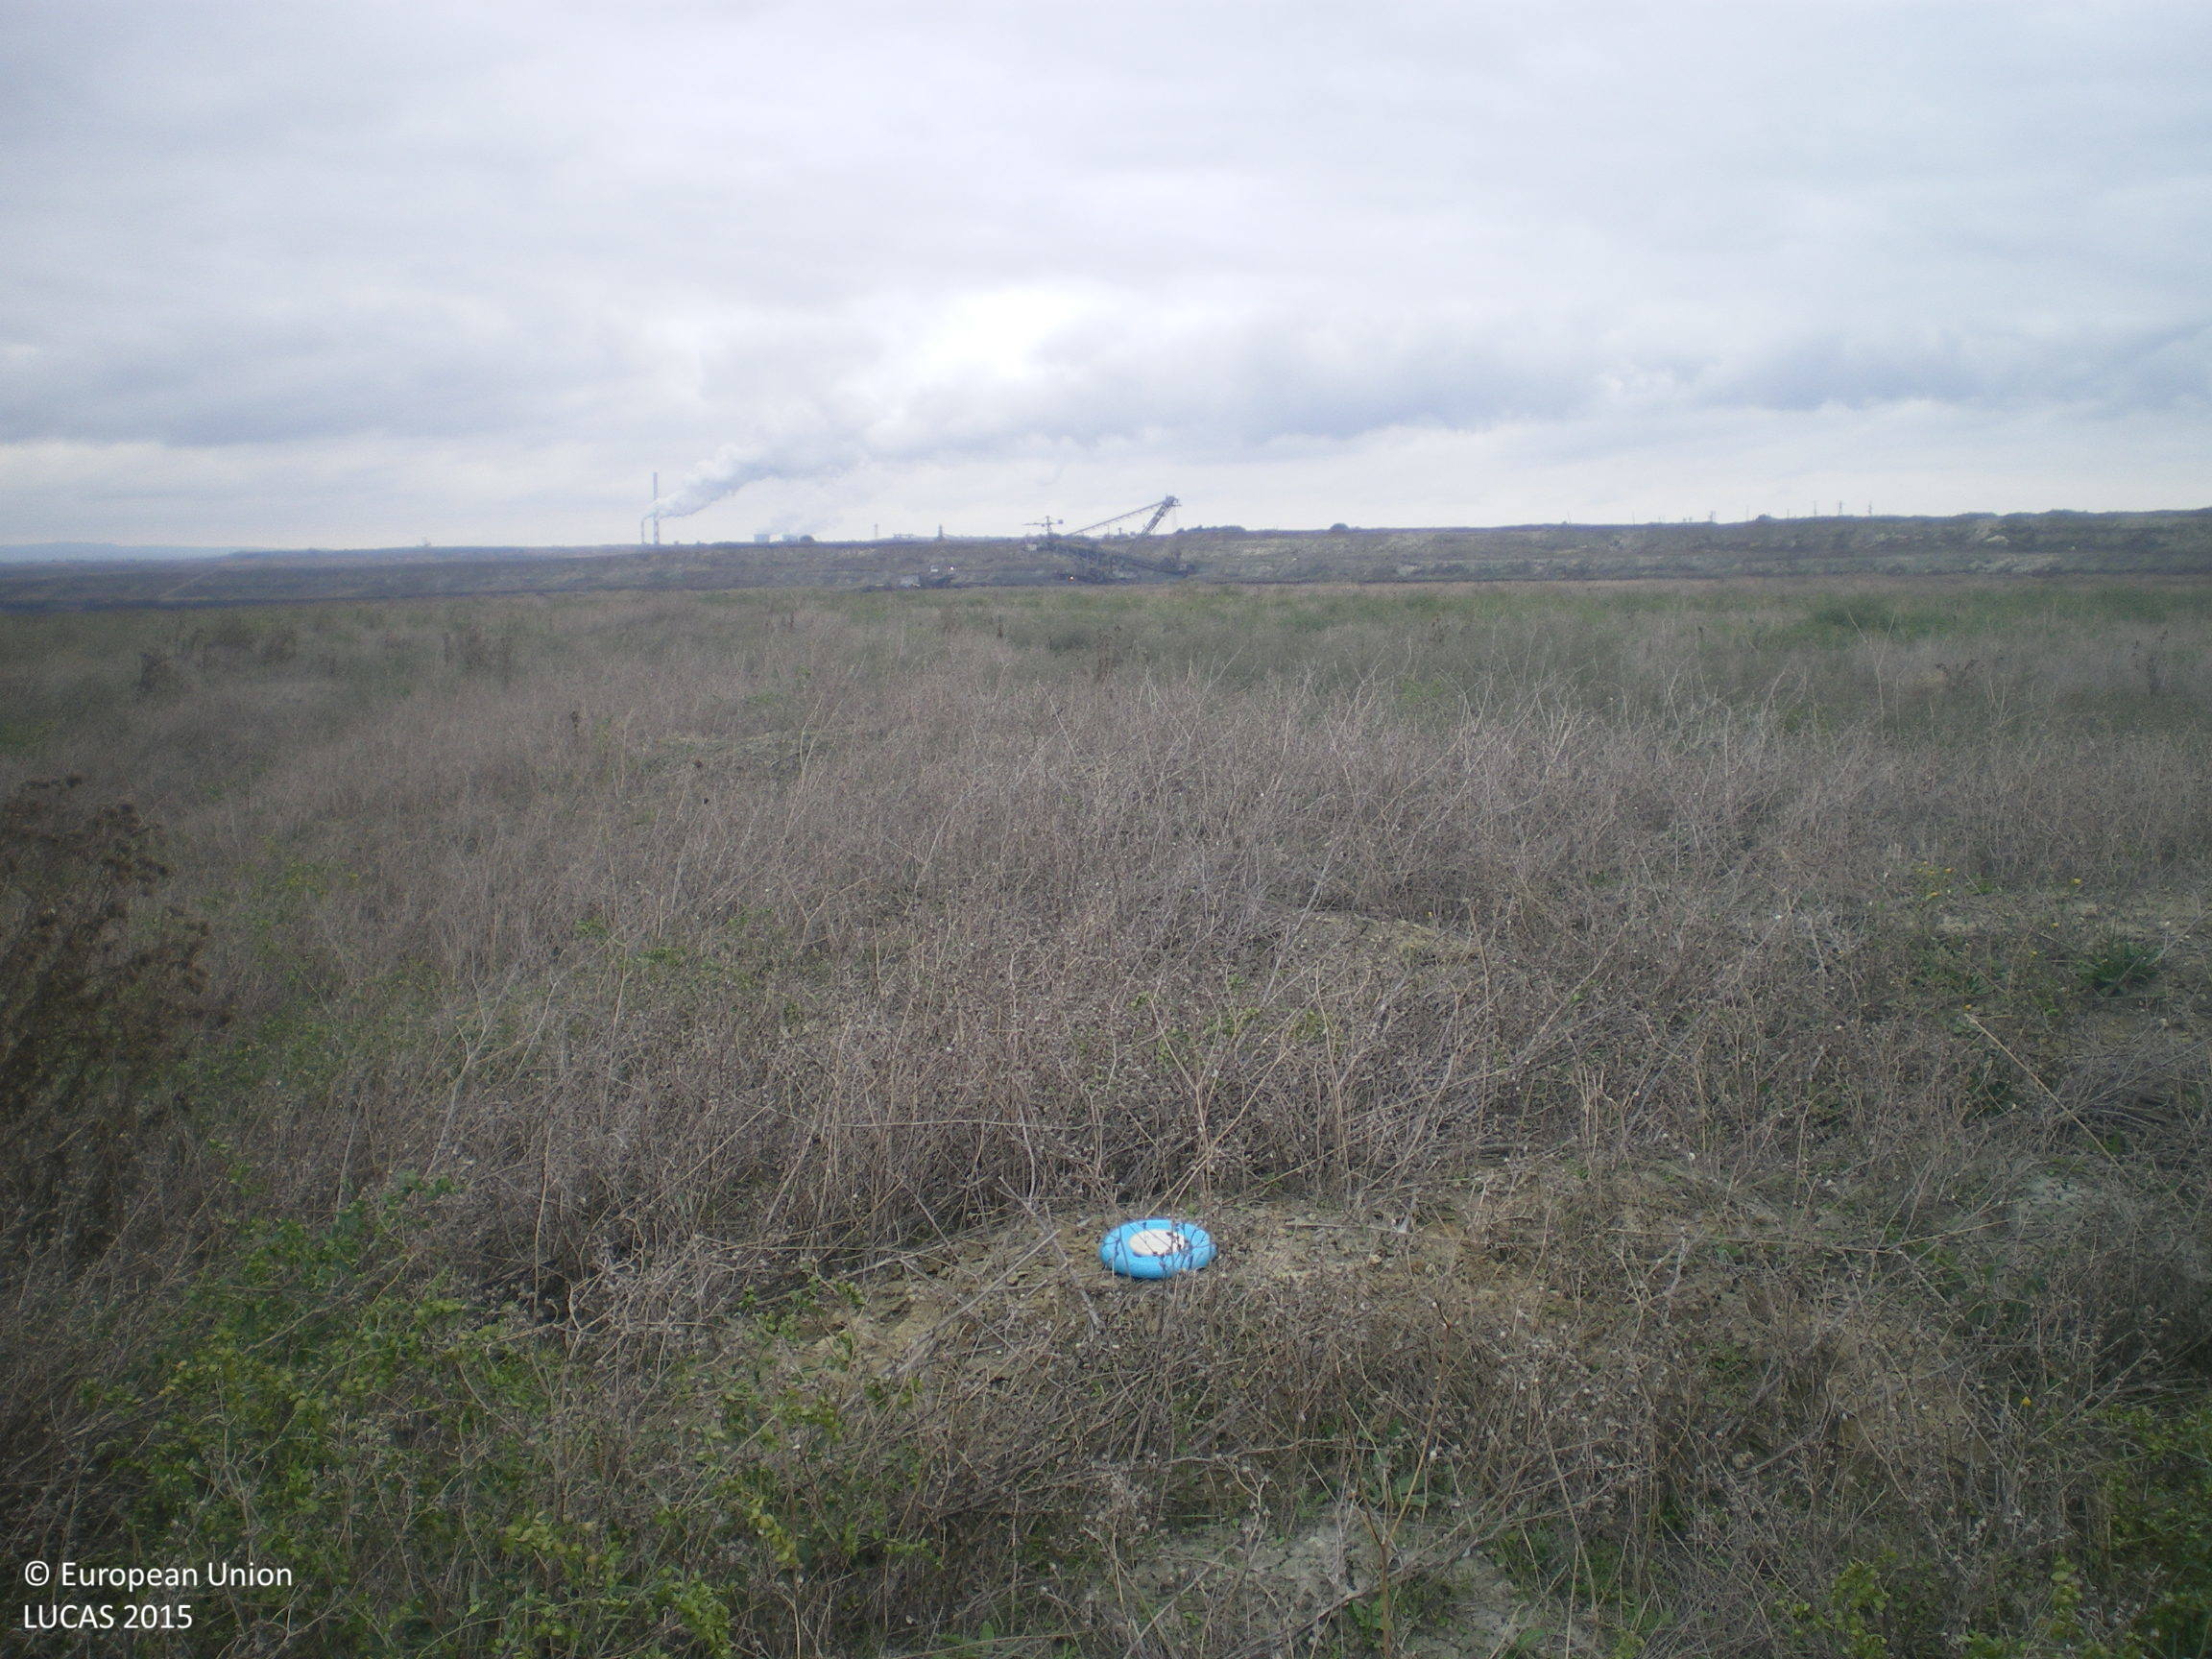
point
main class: Grassland
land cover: Grassland without tree/shrub cover
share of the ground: > 75 %
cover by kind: herbaceous plants 100 %
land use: Mining and quarrying
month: October
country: BG
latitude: 42.2204
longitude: 25.9835
